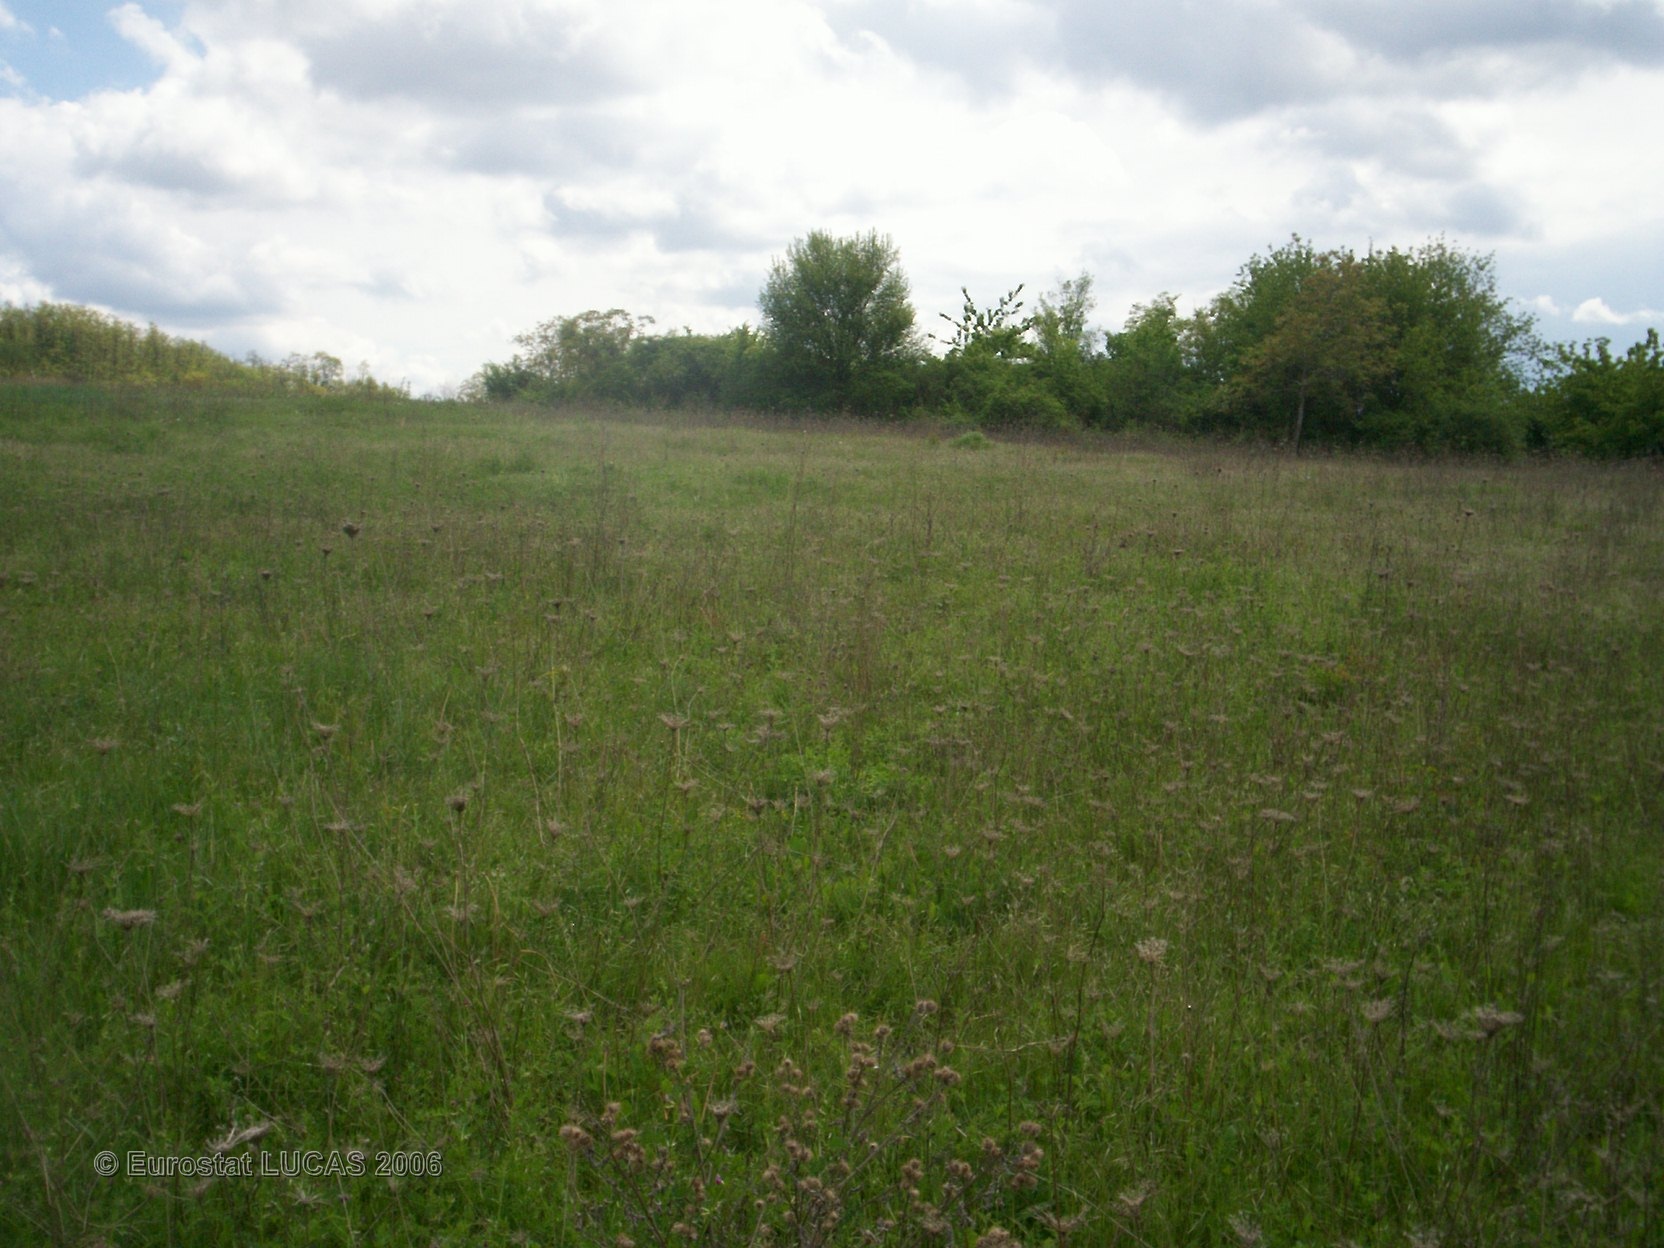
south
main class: Grassland
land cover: Grassland without tree/shrub cover
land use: Agriculture (excluding fallow land and kitchen gardens)
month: May
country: FR
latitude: 45.6996
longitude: 3.1806
